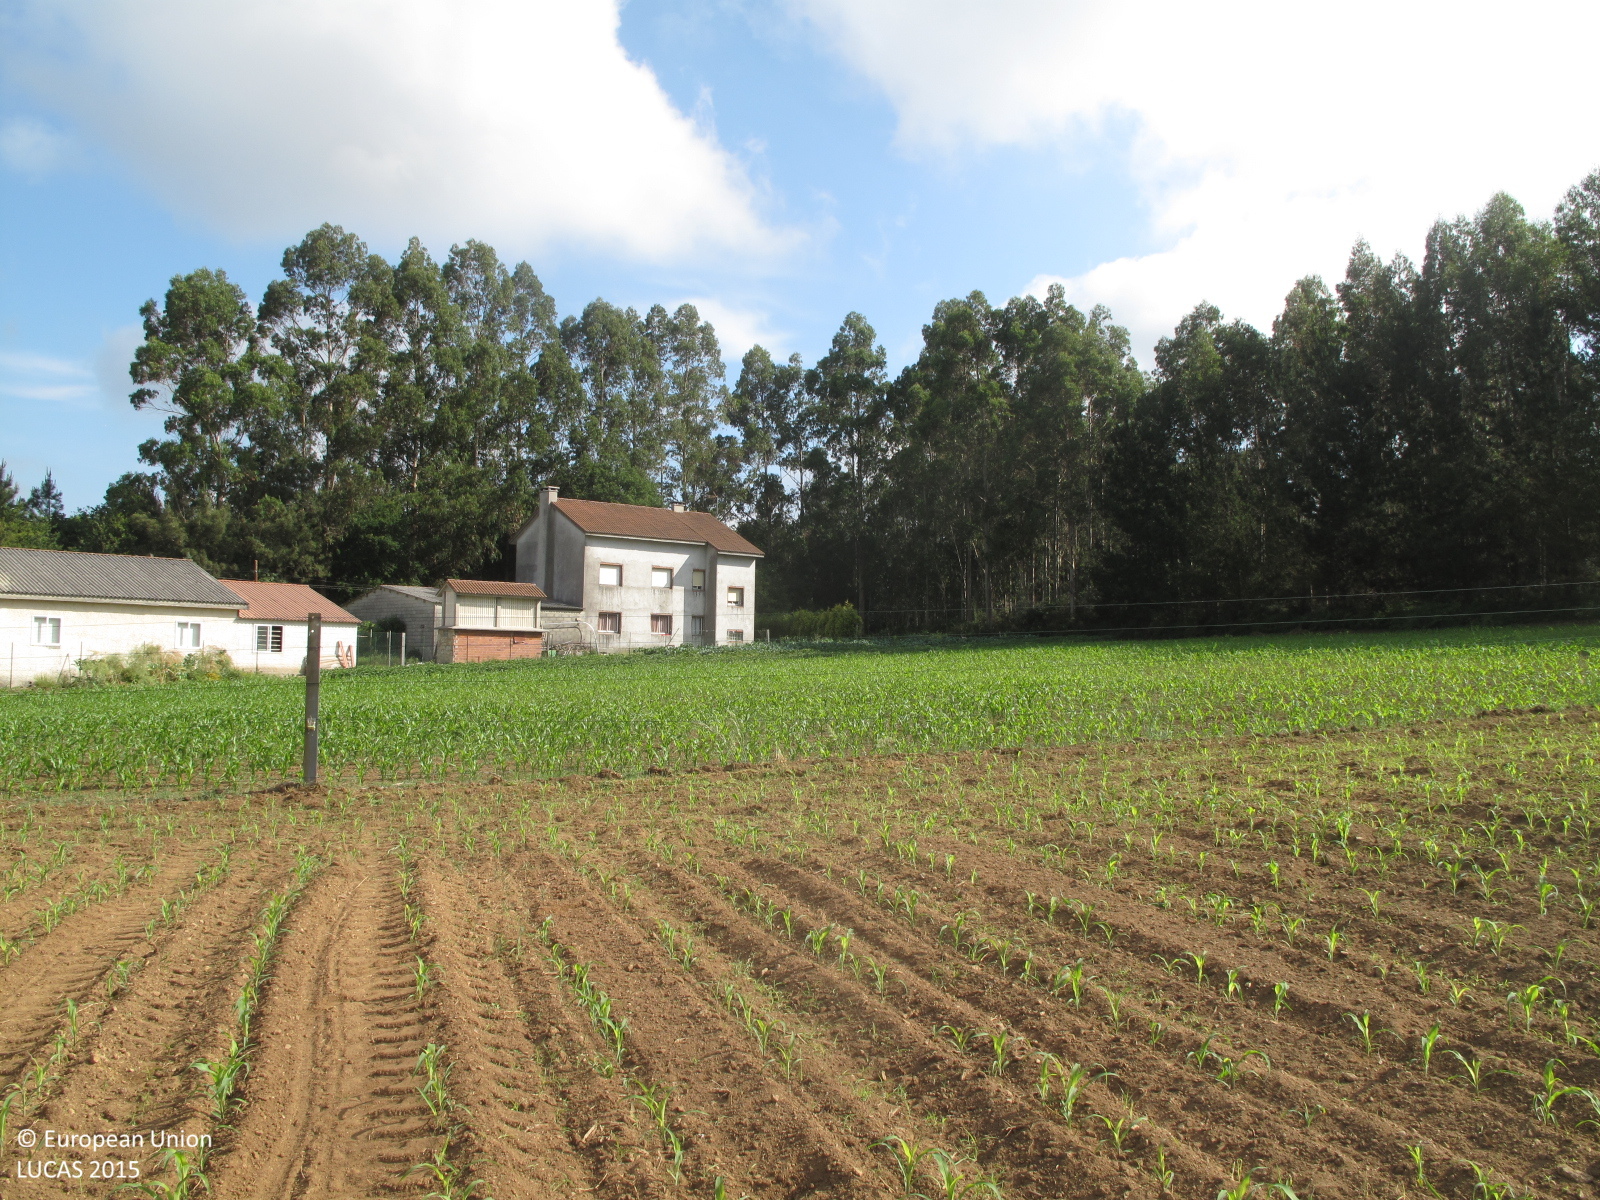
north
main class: Cropland
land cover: Maize
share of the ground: < 10 %
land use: Agriculture (excluding fallow land and kitchen gardens)
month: June
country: ES
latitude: 42.9025
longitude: -8.4361
